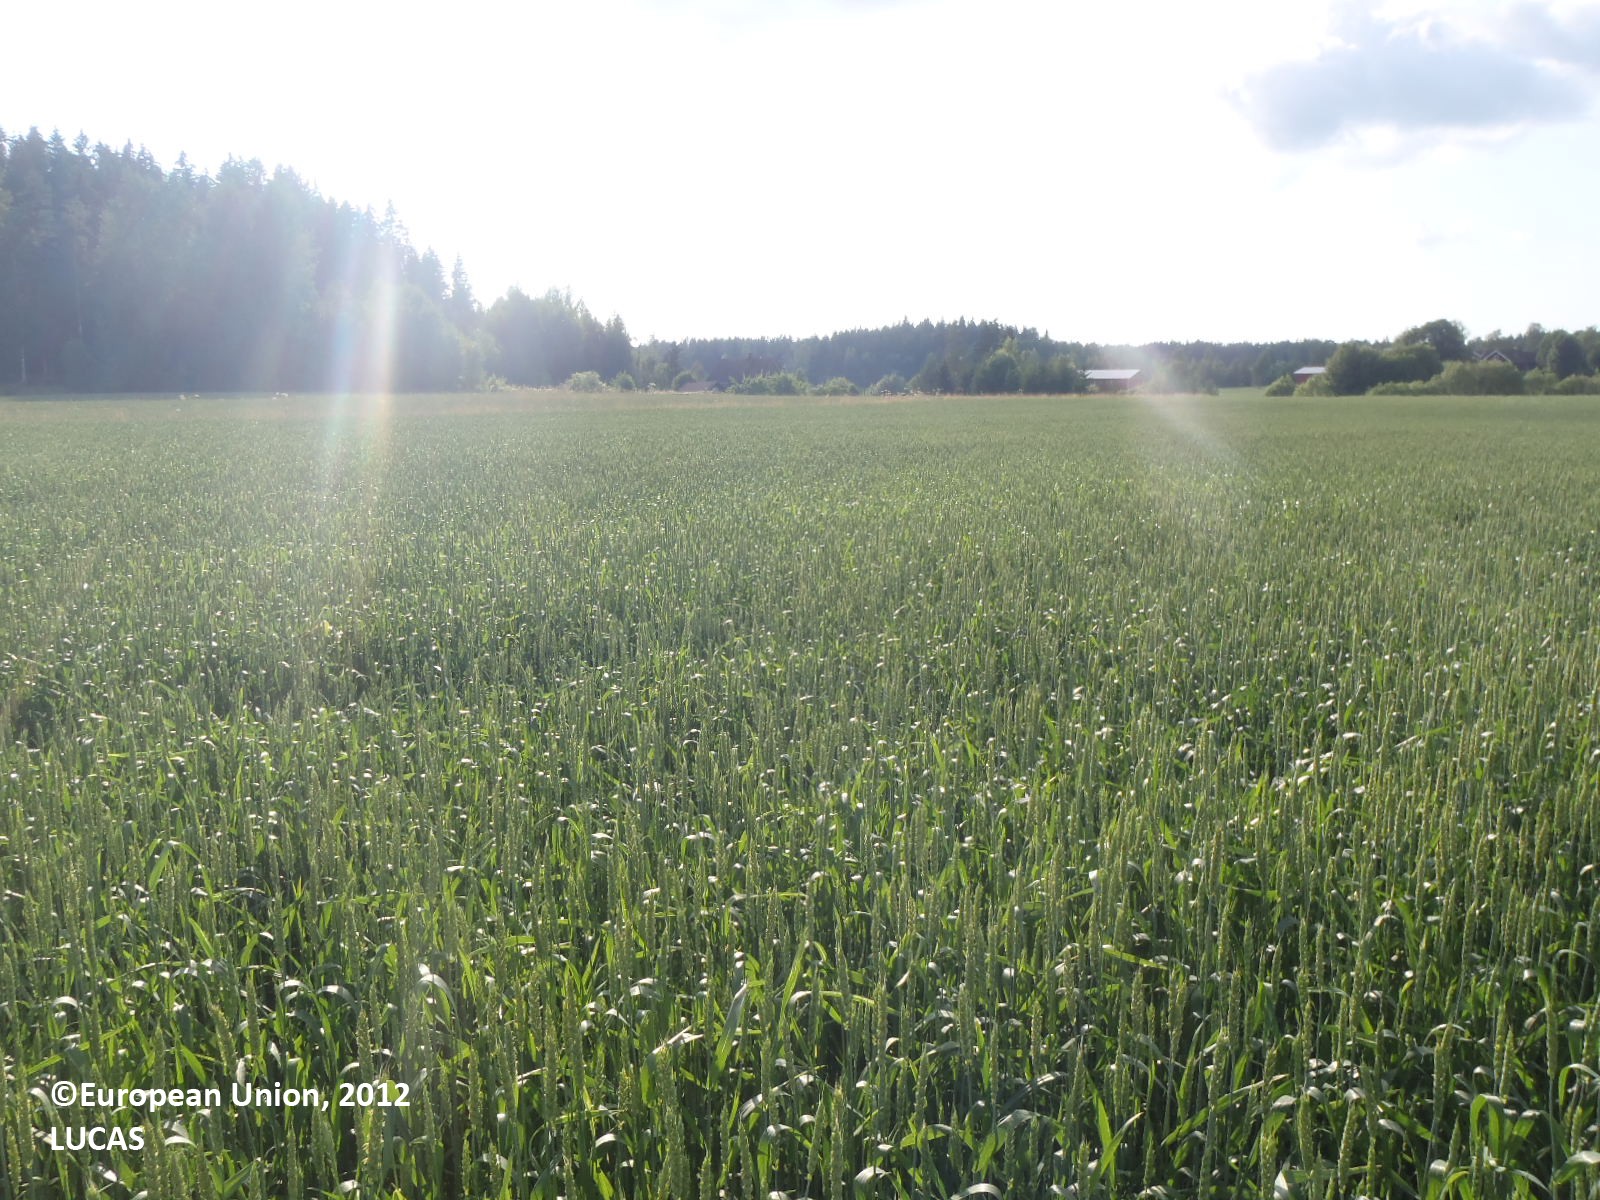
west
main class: Cropland
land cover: Common wheat
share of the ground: 50 - 75 %
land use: Agriculture (excluding fallow land and kitchen gardens)
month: July
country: FI
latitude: 60.5678
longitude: 22.1234
